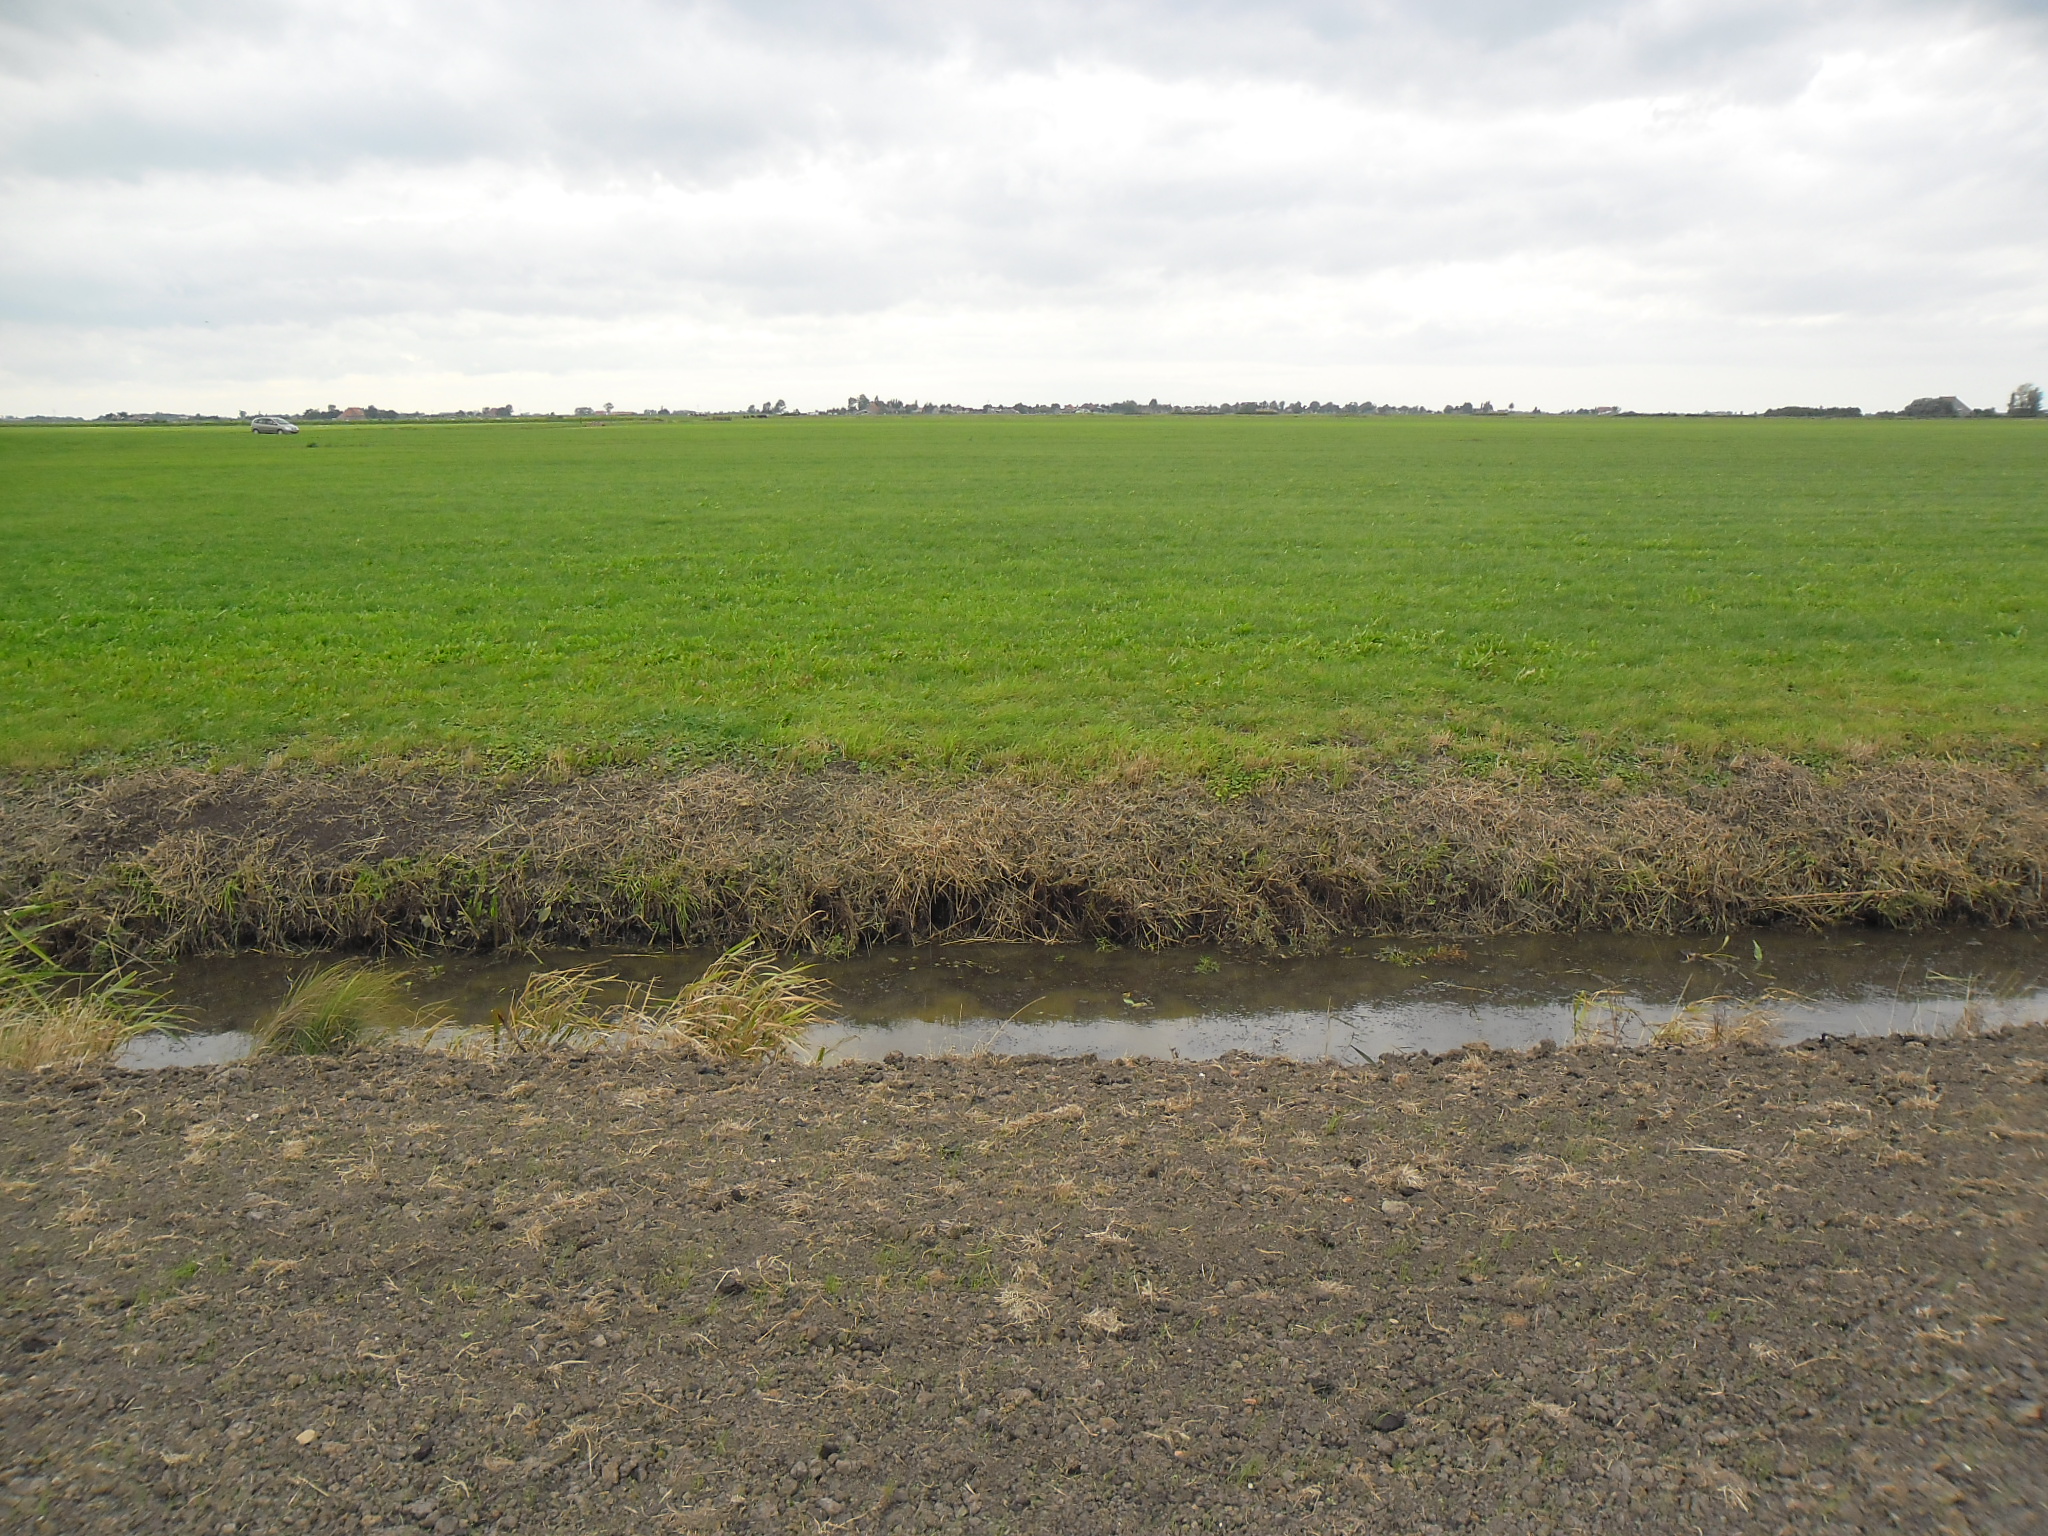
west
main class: Grassland
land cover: Grassland without tree/shrub cover
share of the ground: < 10 %
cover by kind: consolidated bare surface 90 %, herbaceous plants 10 %
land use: Agriculture (excluding fallow land and kitchen gardens)
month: August
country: NL
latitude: 52.9612
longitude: 5.5773
